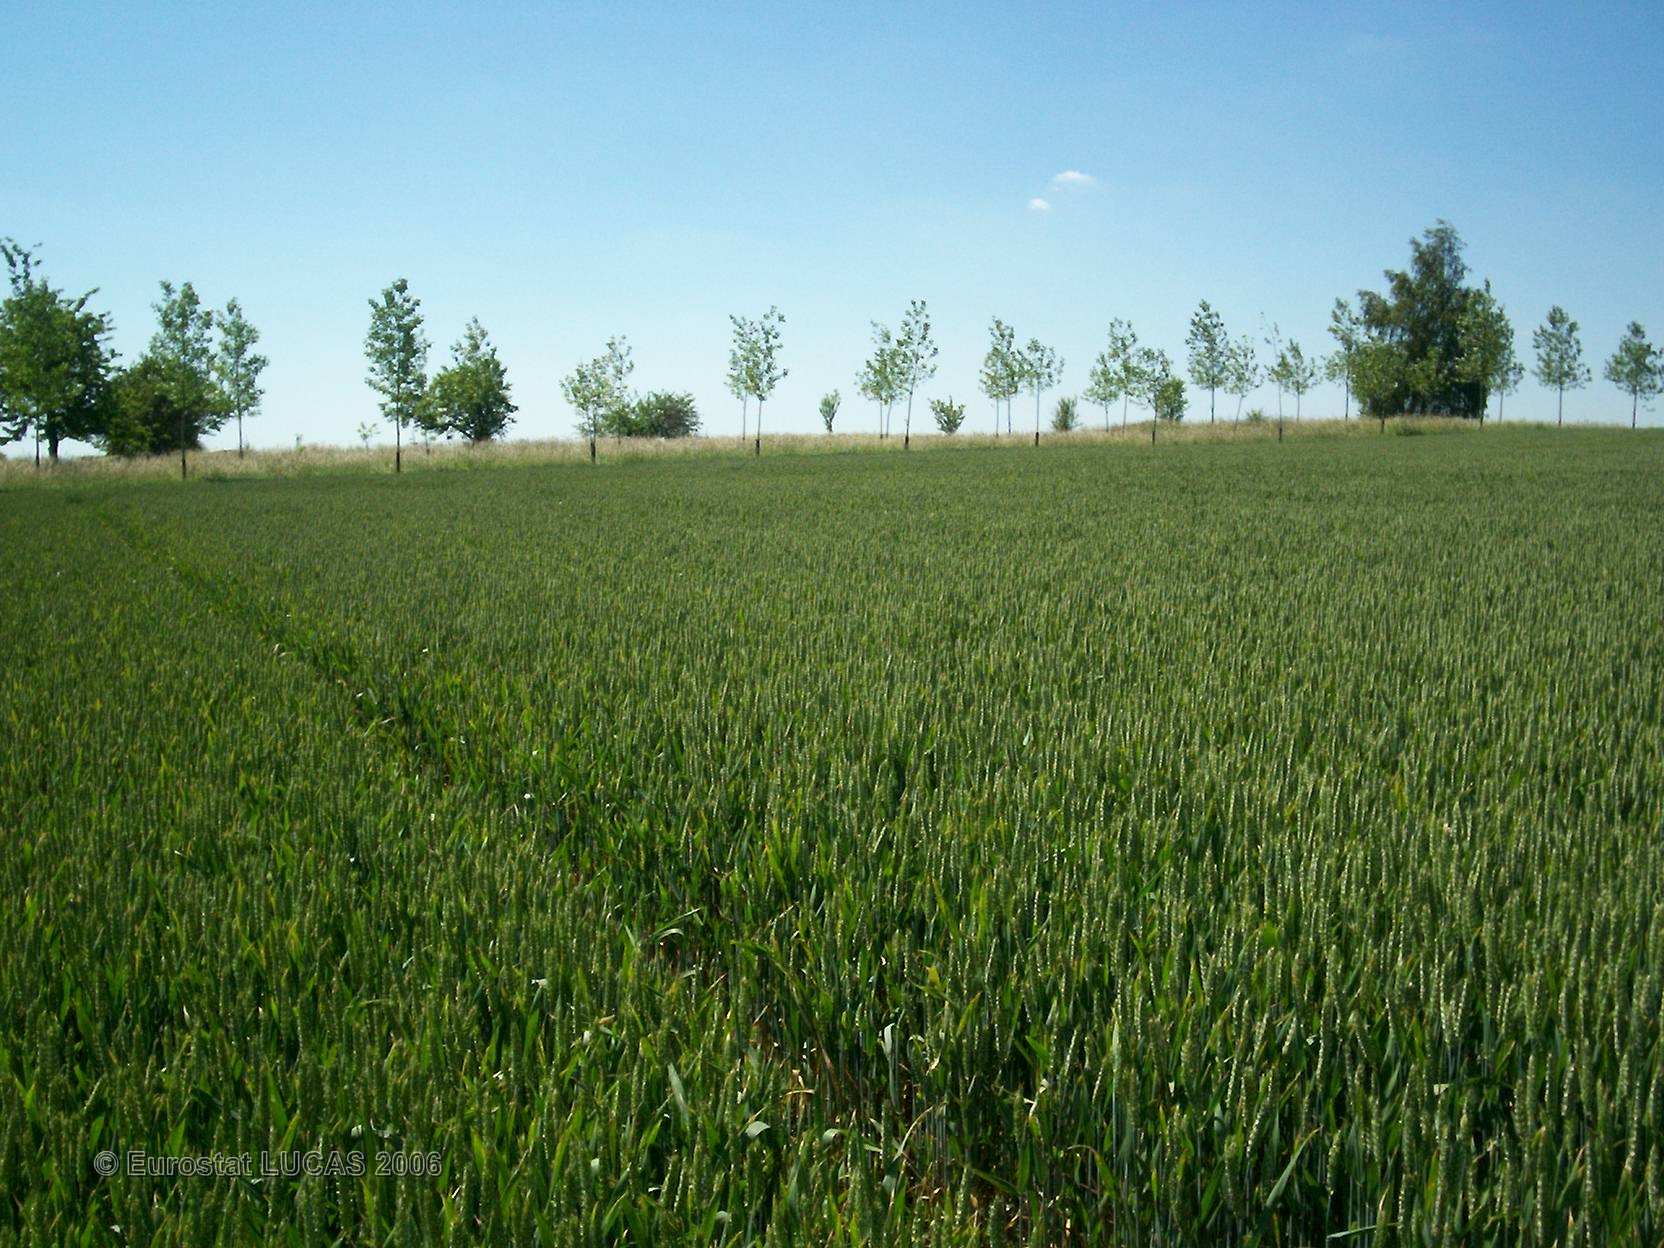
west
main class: Cropland
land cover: Common wheat
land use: Agriculture (excluding fallow land and kitchen gardens)
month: June
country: FR
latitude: 48.6968
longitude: 4.8213
